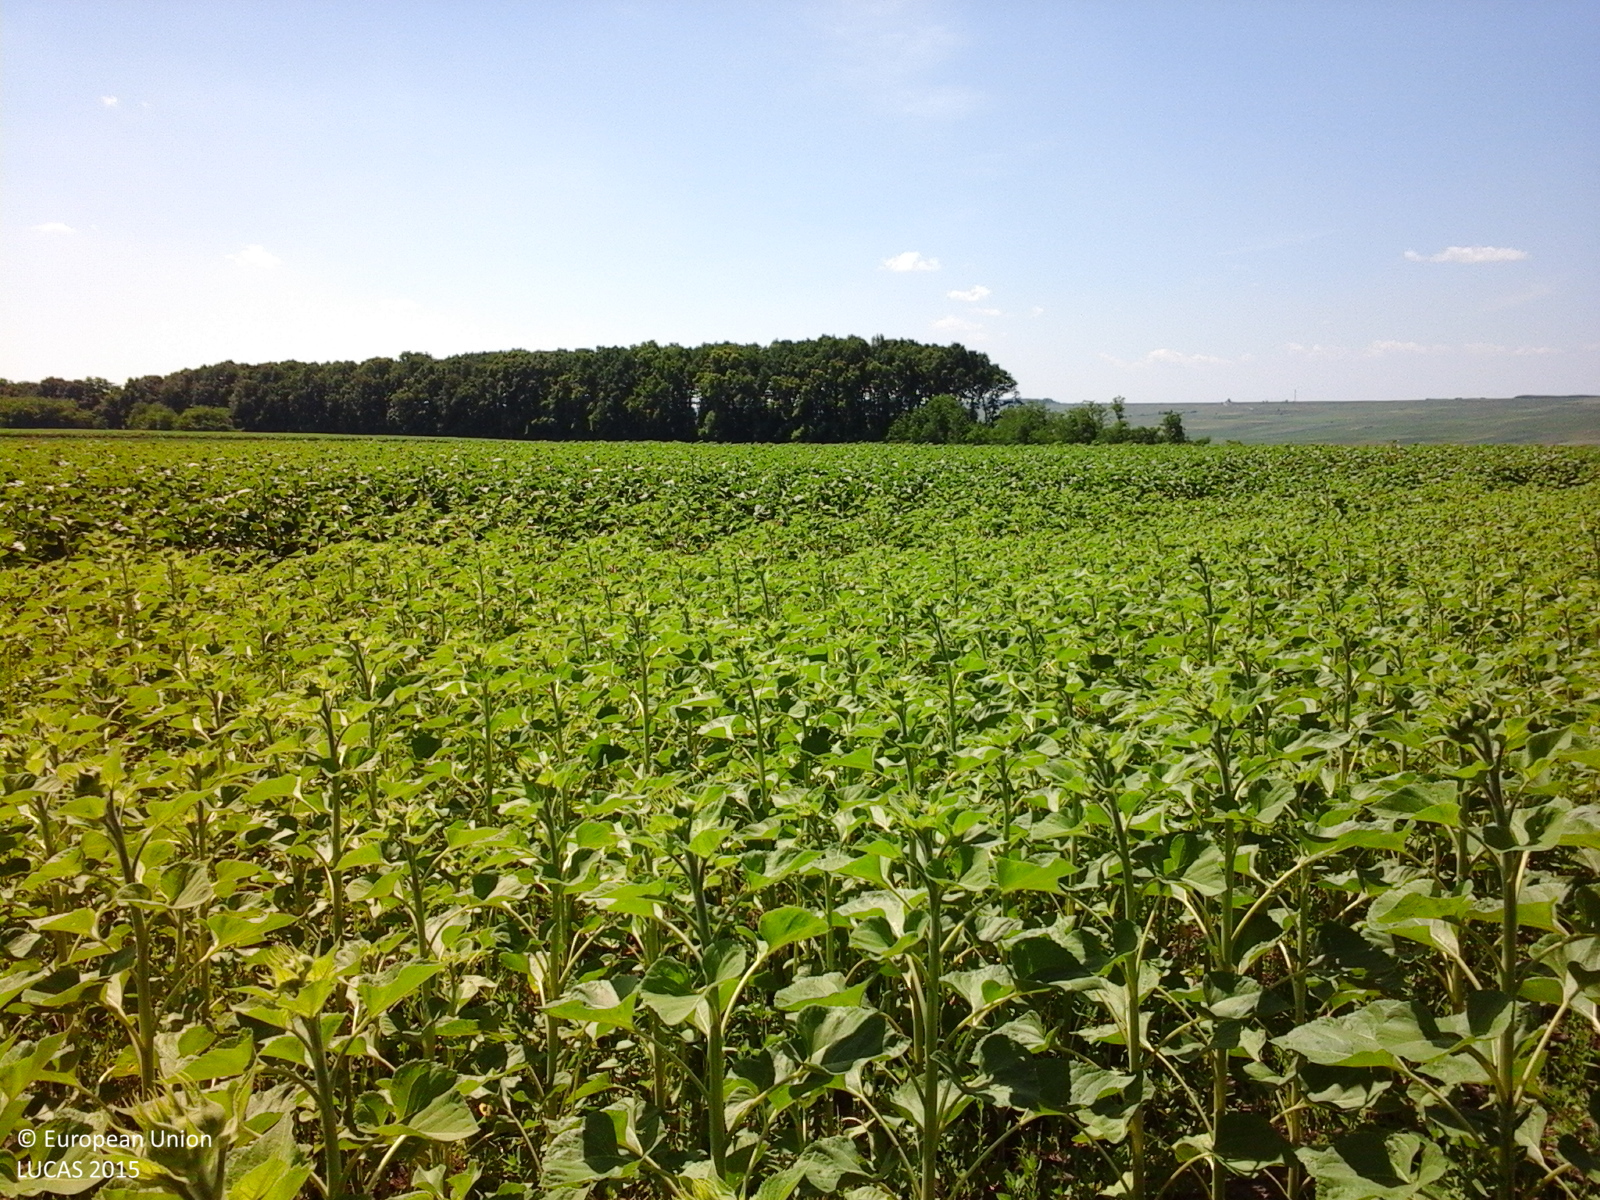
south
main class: Cropland
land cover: Sunflower
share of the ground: > 75 %
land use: Agriculture (excluding fallow land and kitchen gardens)
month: June
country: RO
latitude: 48.1784
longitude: 26.8746
